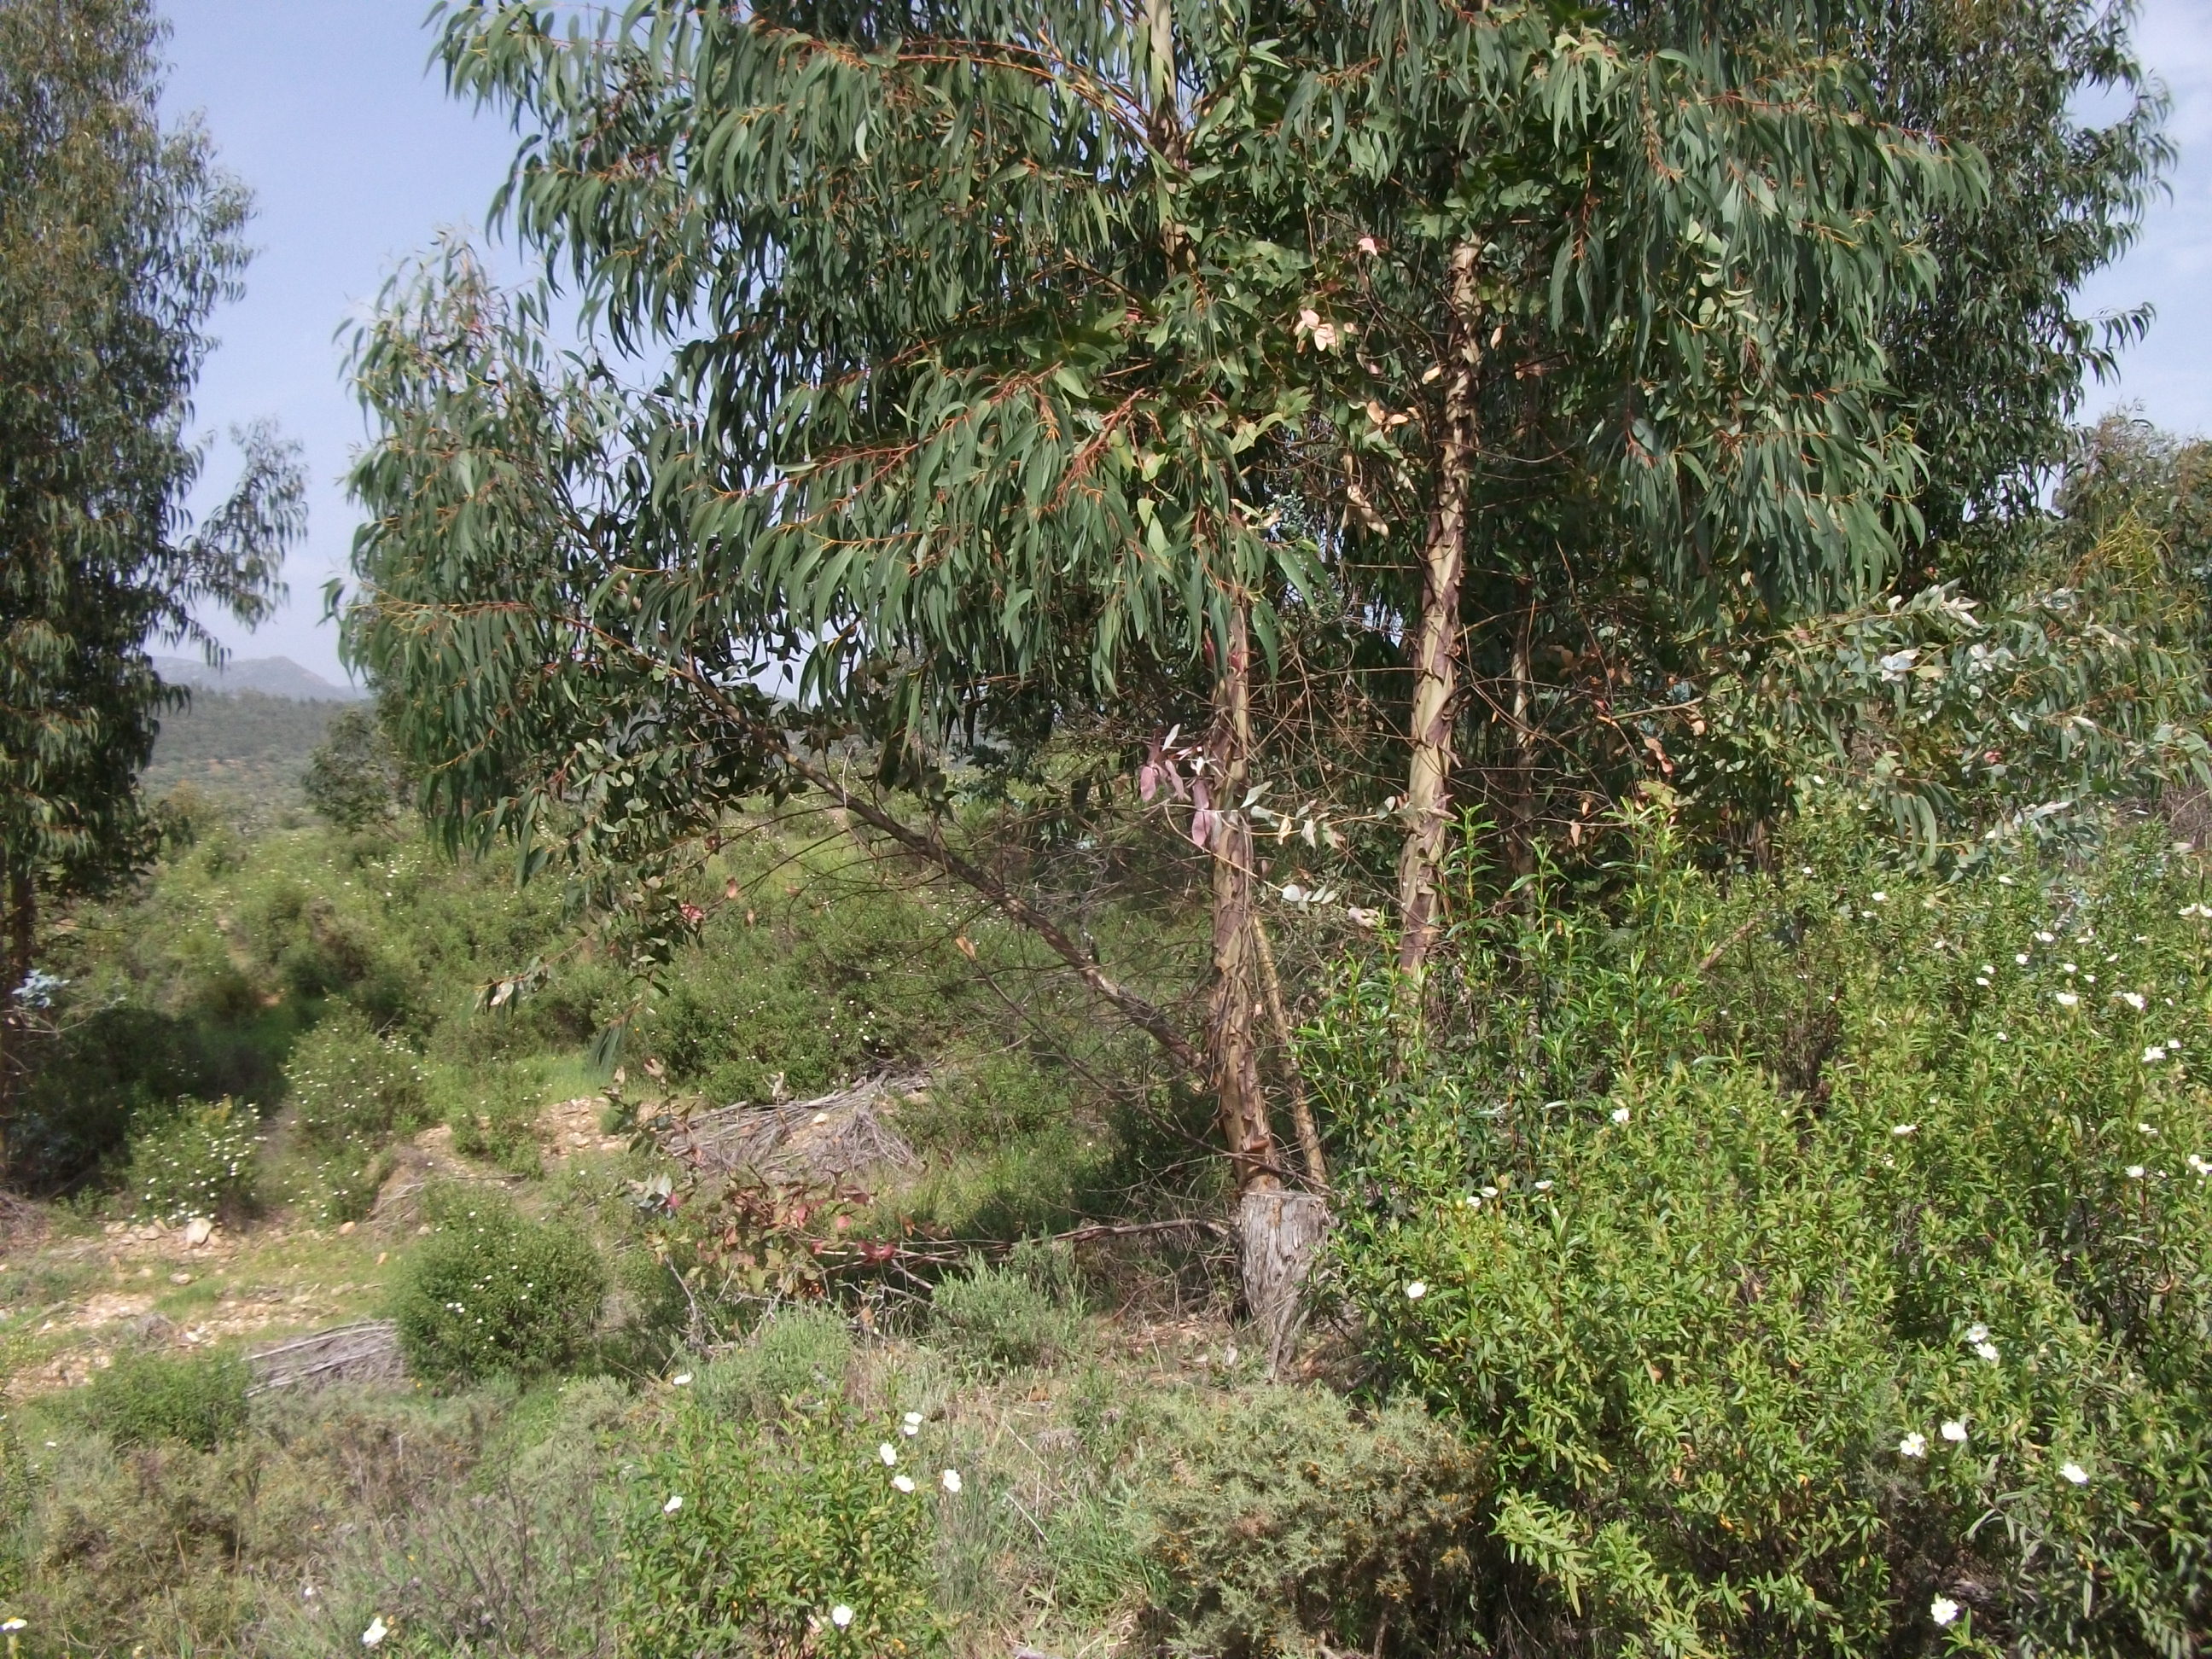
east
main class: Shrubland
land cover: Shrubland with sparse tree cover
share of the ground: > 75 %
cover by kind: shrubs 80 %, herbaceous plants 15 %, broadleaved forest trees 5 %
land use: Agriculture (excluding fallow land and kitchen gardens)
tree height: > 5 m
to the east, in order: Shrubland with sparse tree cover; Broadleaved woodland; Tracks; Fences; Grassland with sparse tree/shrub cover; Fences; Broadleaved woodland; Fences; Broadleaved woodland; Ditches and canals; Paved roads, cycling and walking lanes; Ditches and canals; Shrubland with sparse tree cover; Fences; Broadleaved woodland
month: April
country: ES
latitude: 37.8049
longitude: -6.7296
